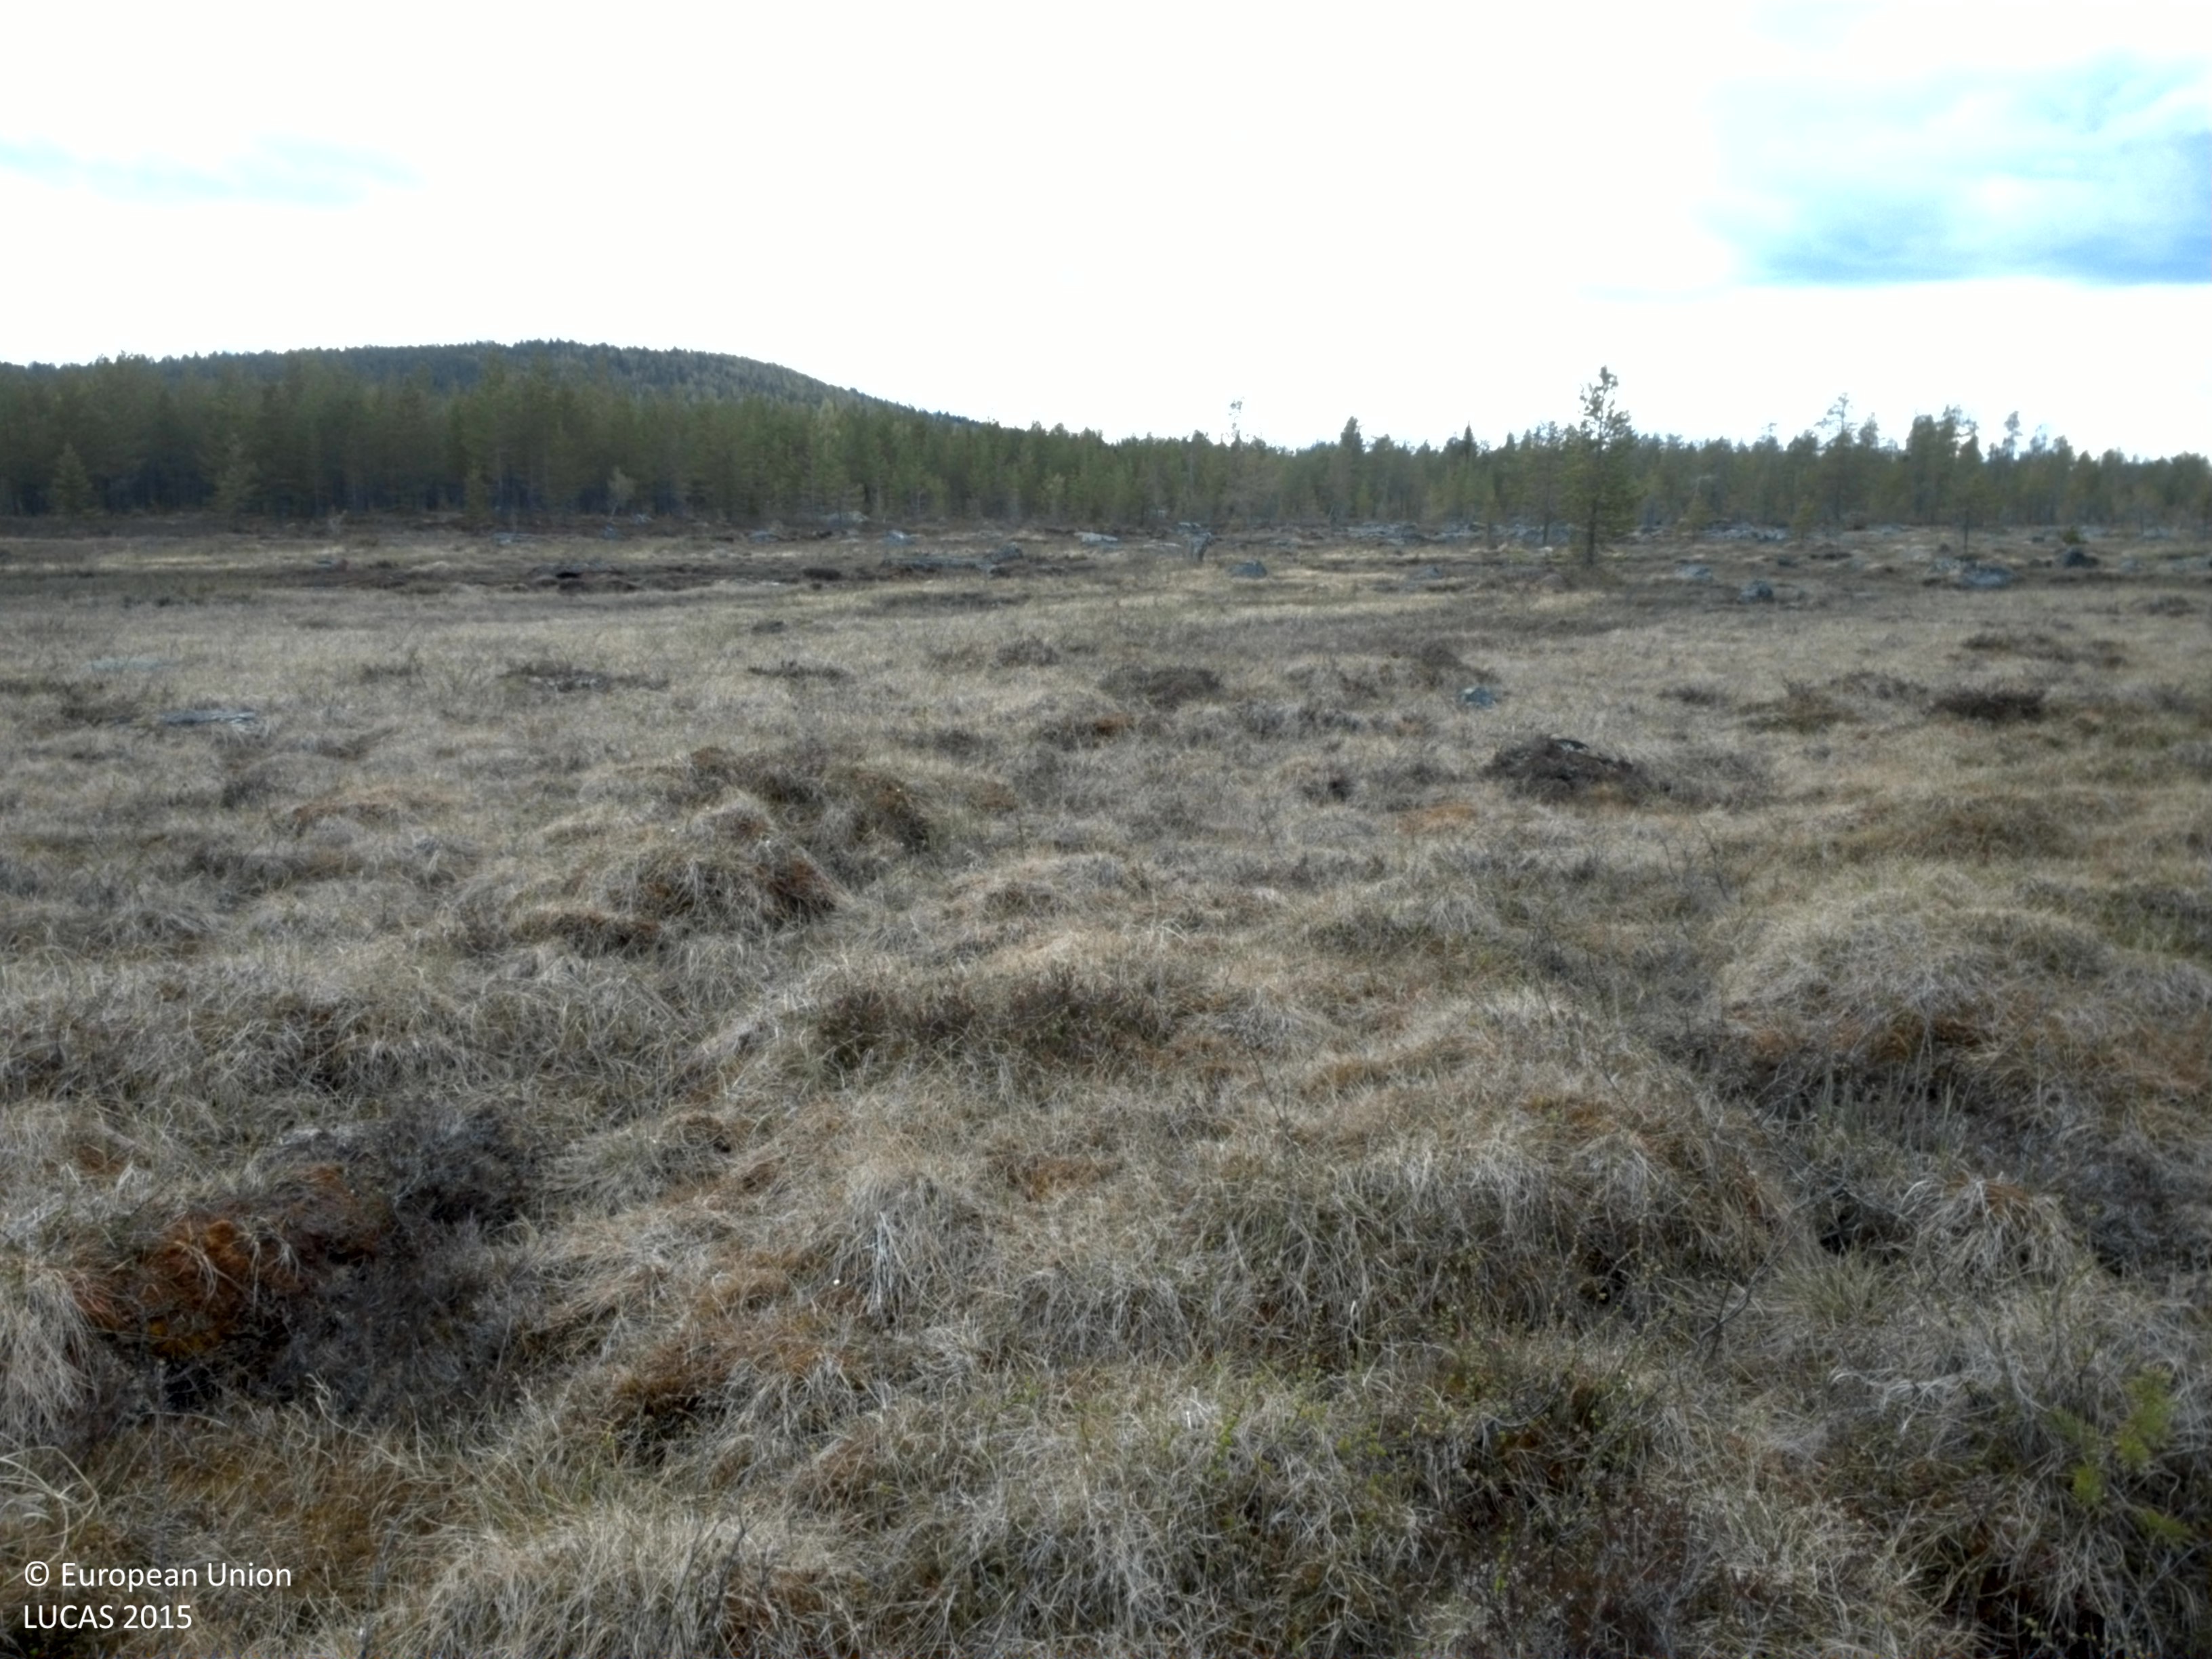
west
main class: Shrubland
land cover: Shrubland without tree cover
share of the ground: 25 - 50 %
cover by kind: herbaceous plants 60 %, shrubs 40 %
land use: Semi-natural and natural areas not in use
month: June
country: SE
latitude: 66.2526
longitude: 18.6992
